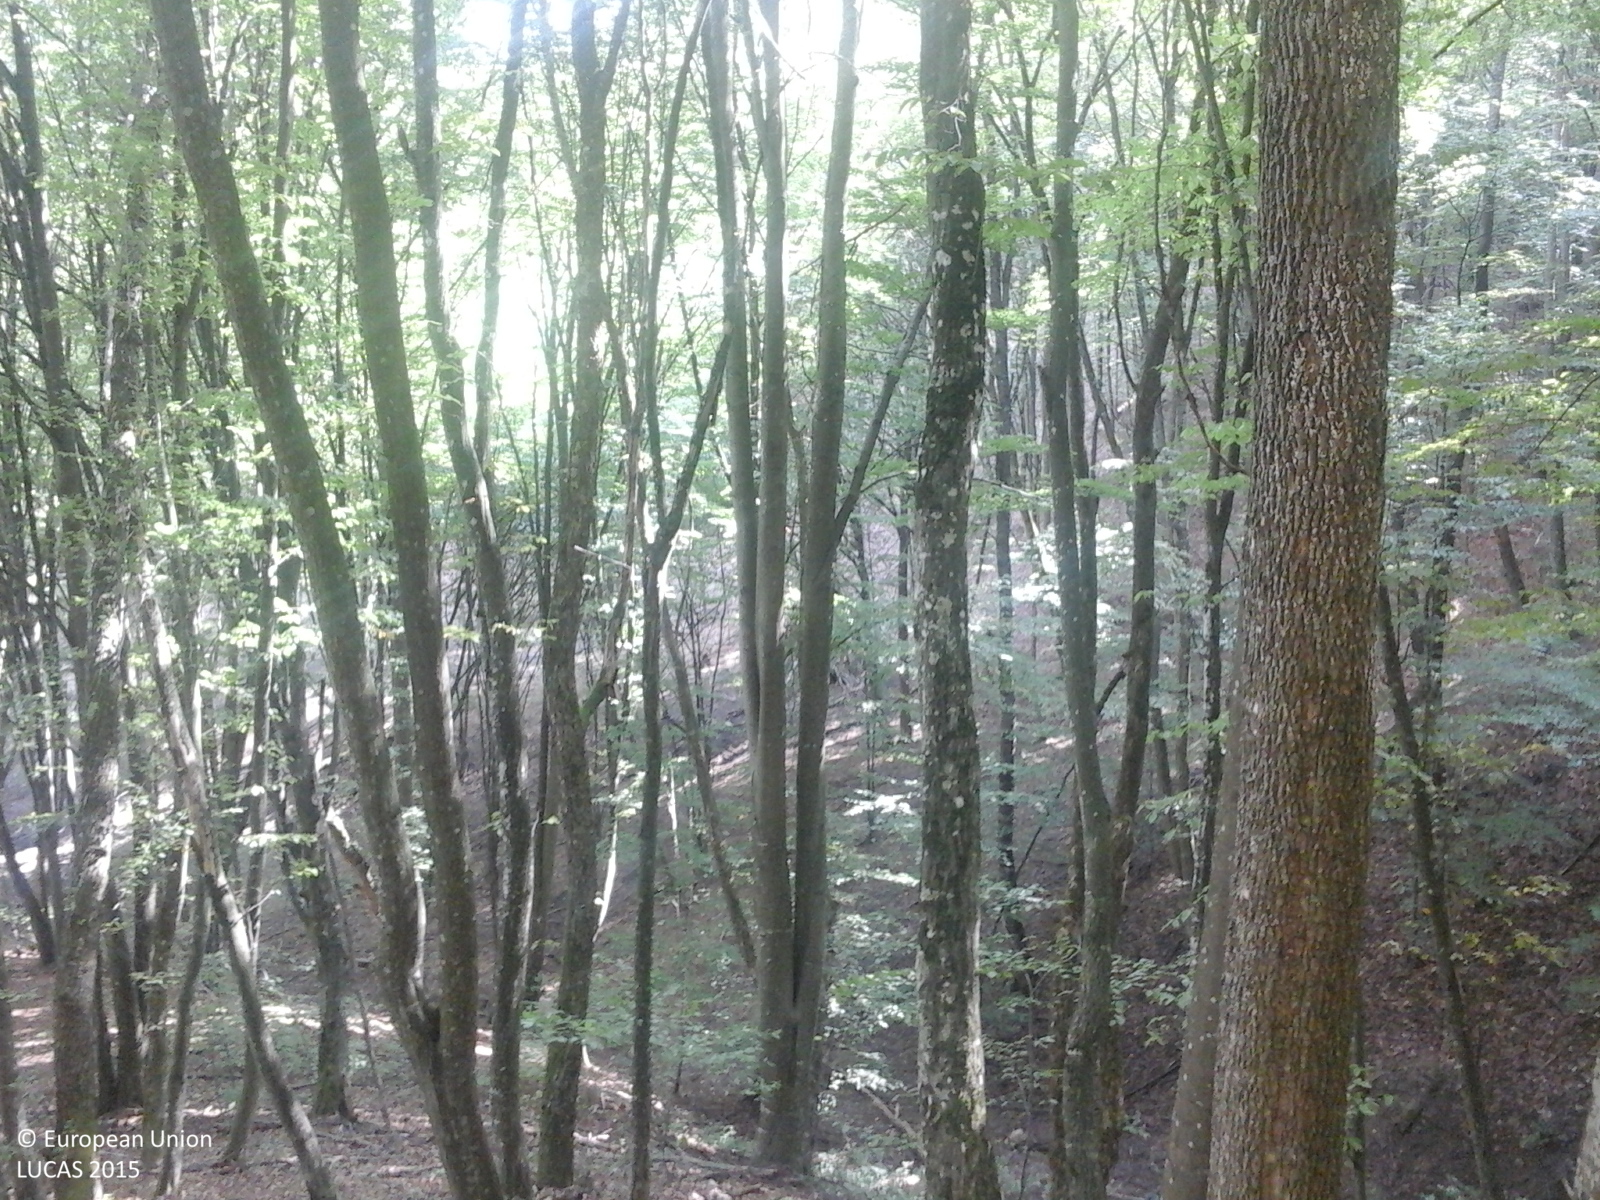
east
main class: Woodland
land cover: Broadleaved woodland
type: beech forest
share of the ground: > 75 %
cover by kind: broadleaved forest trees 100 %
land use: Forestry
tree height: > 5 m
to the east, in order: Broadleaved woodland
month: September
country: RO
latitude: 47.2924
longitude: 23.6827
